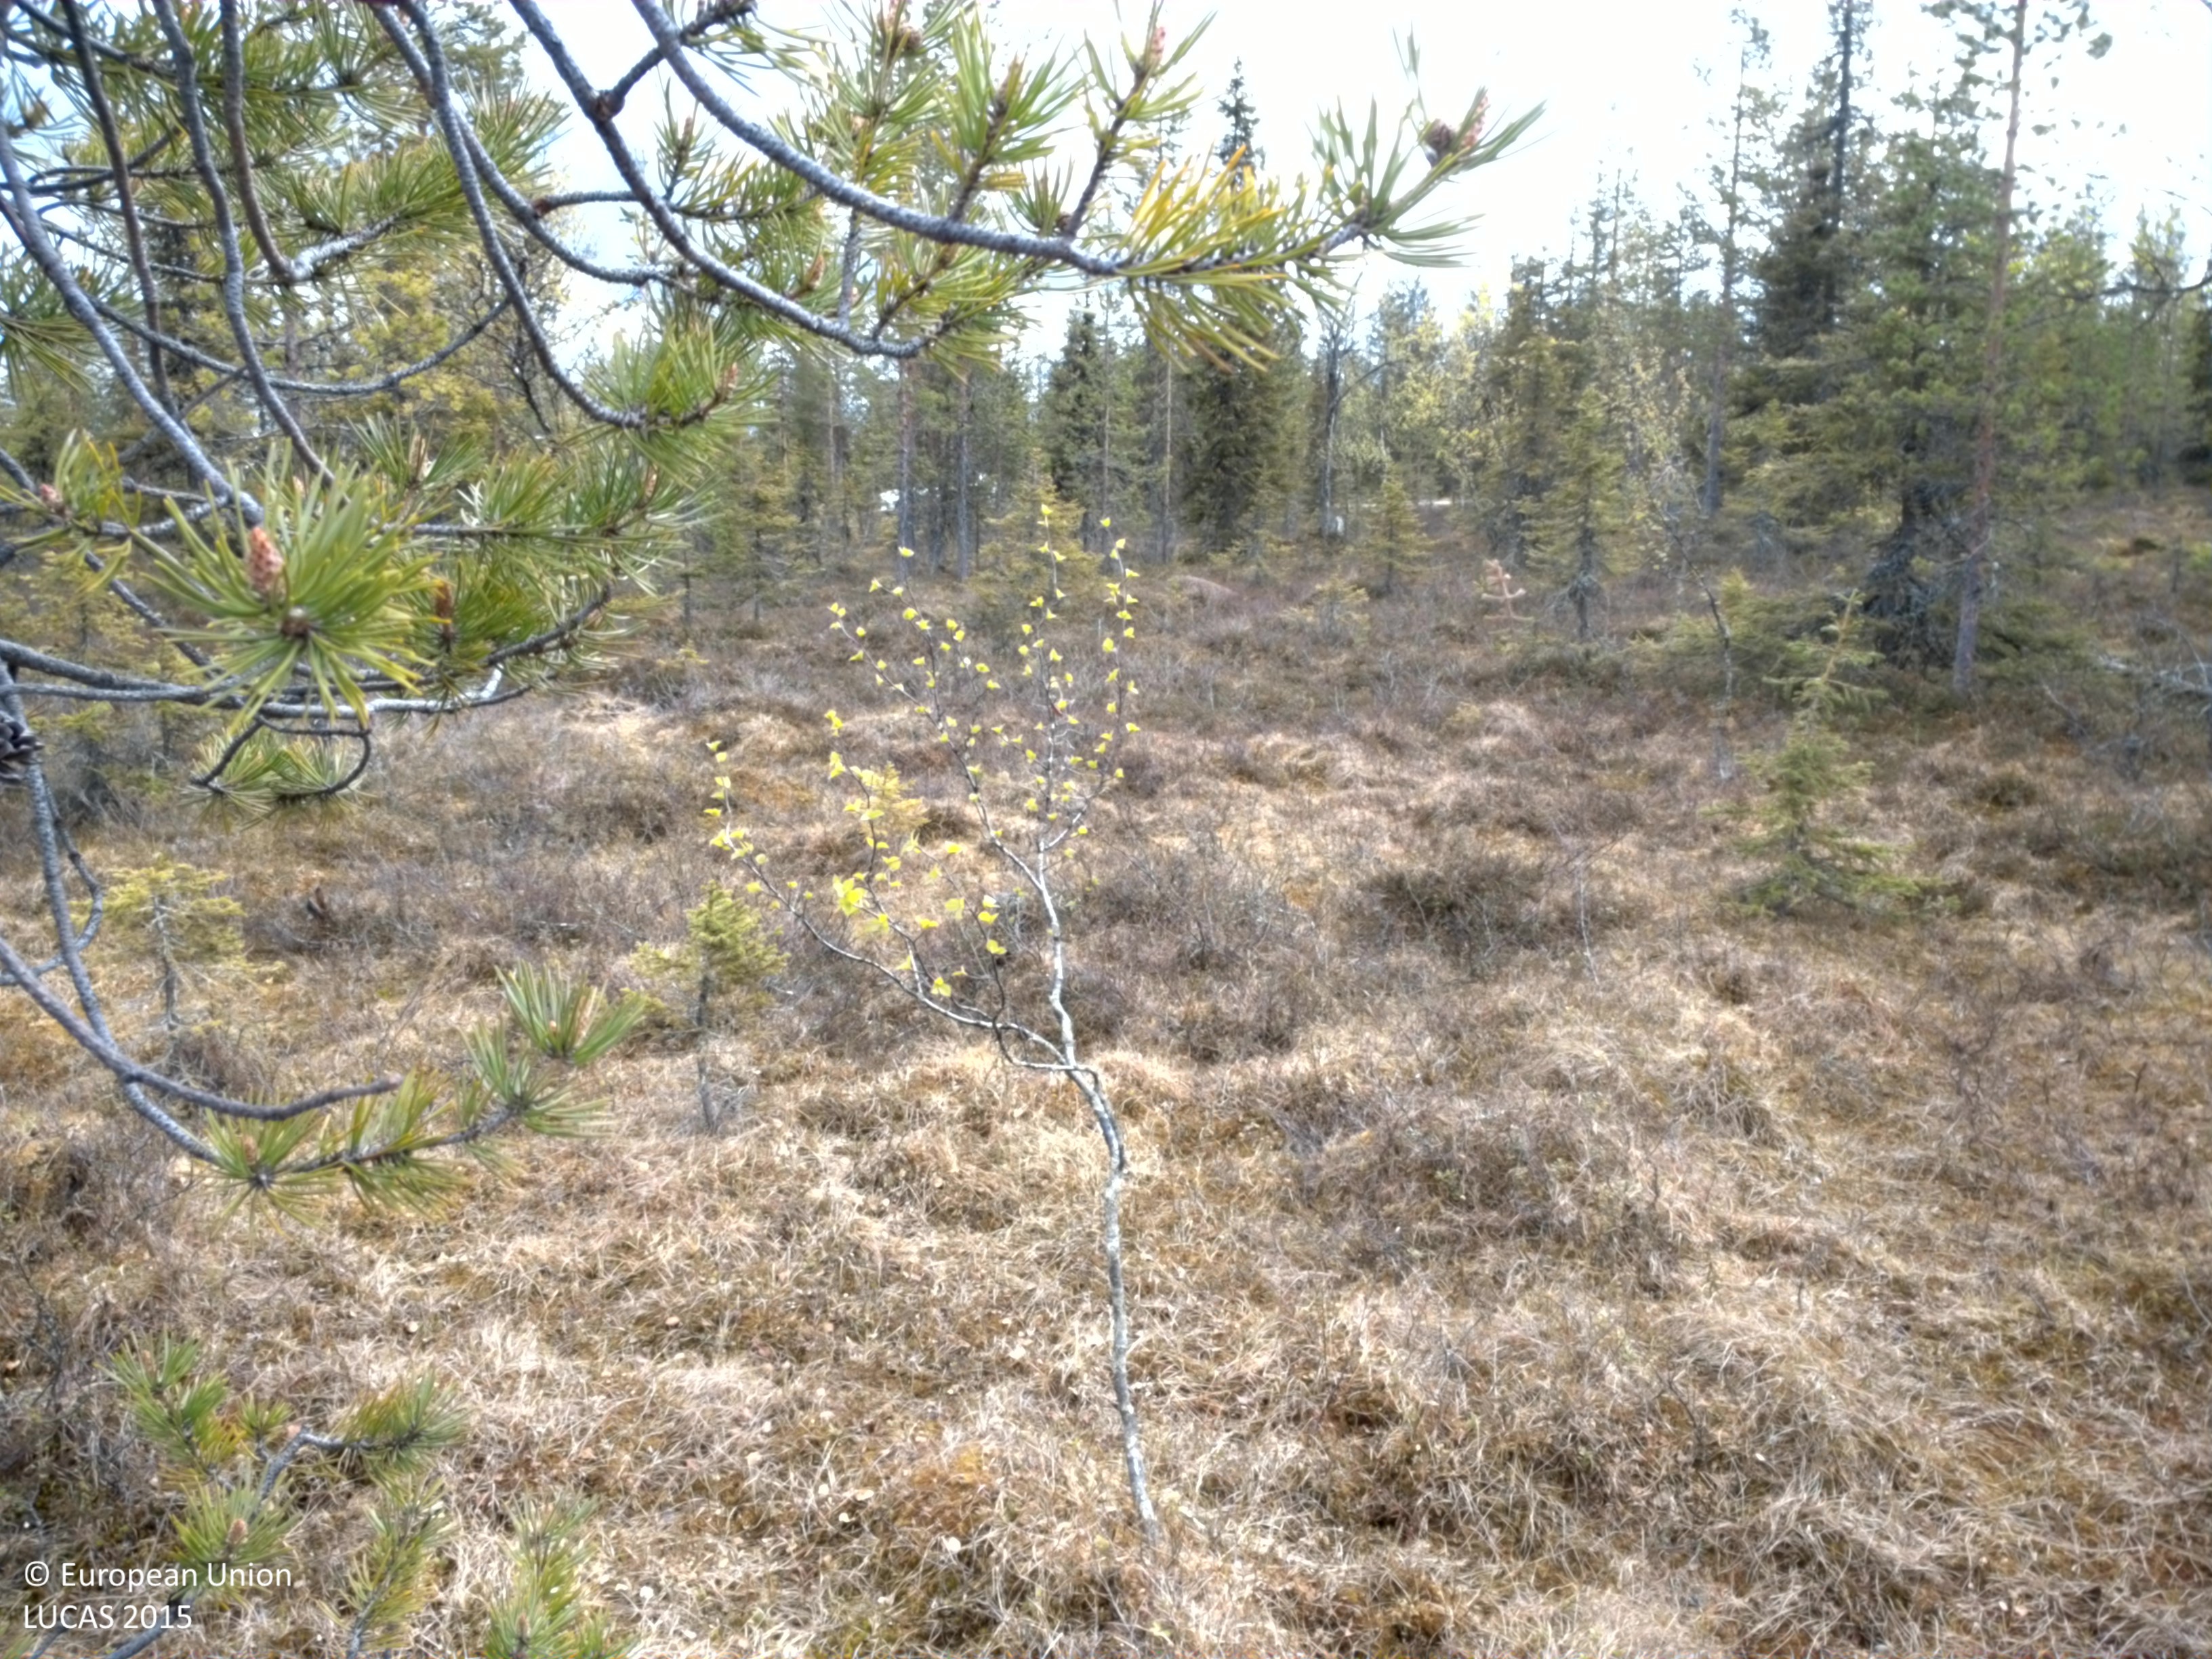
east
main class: Woodland
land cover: Pine dominated coniferous woodland
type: mire and swamp forests
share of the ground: 10 - 25 %
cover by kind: shrubs 50 %, herbaceous plants 35 %, coniferous forest trees 15 %
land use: Semi-natural and natural areas not in use
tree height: > 5 m
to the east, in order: Pine dominated coniferous woodland; Other coniferous woodland; Ditches and canals; Groves; Tracks; Groves; Ditches and canals; Pine dominated coniferous woodland; Shrubland with sparse tree cover; Pine dominated coniferous woodland; Other coniferous woodland; Pine dominated coniferous woodland
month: June
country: SE
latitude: 66.0823
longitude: 18.8192
